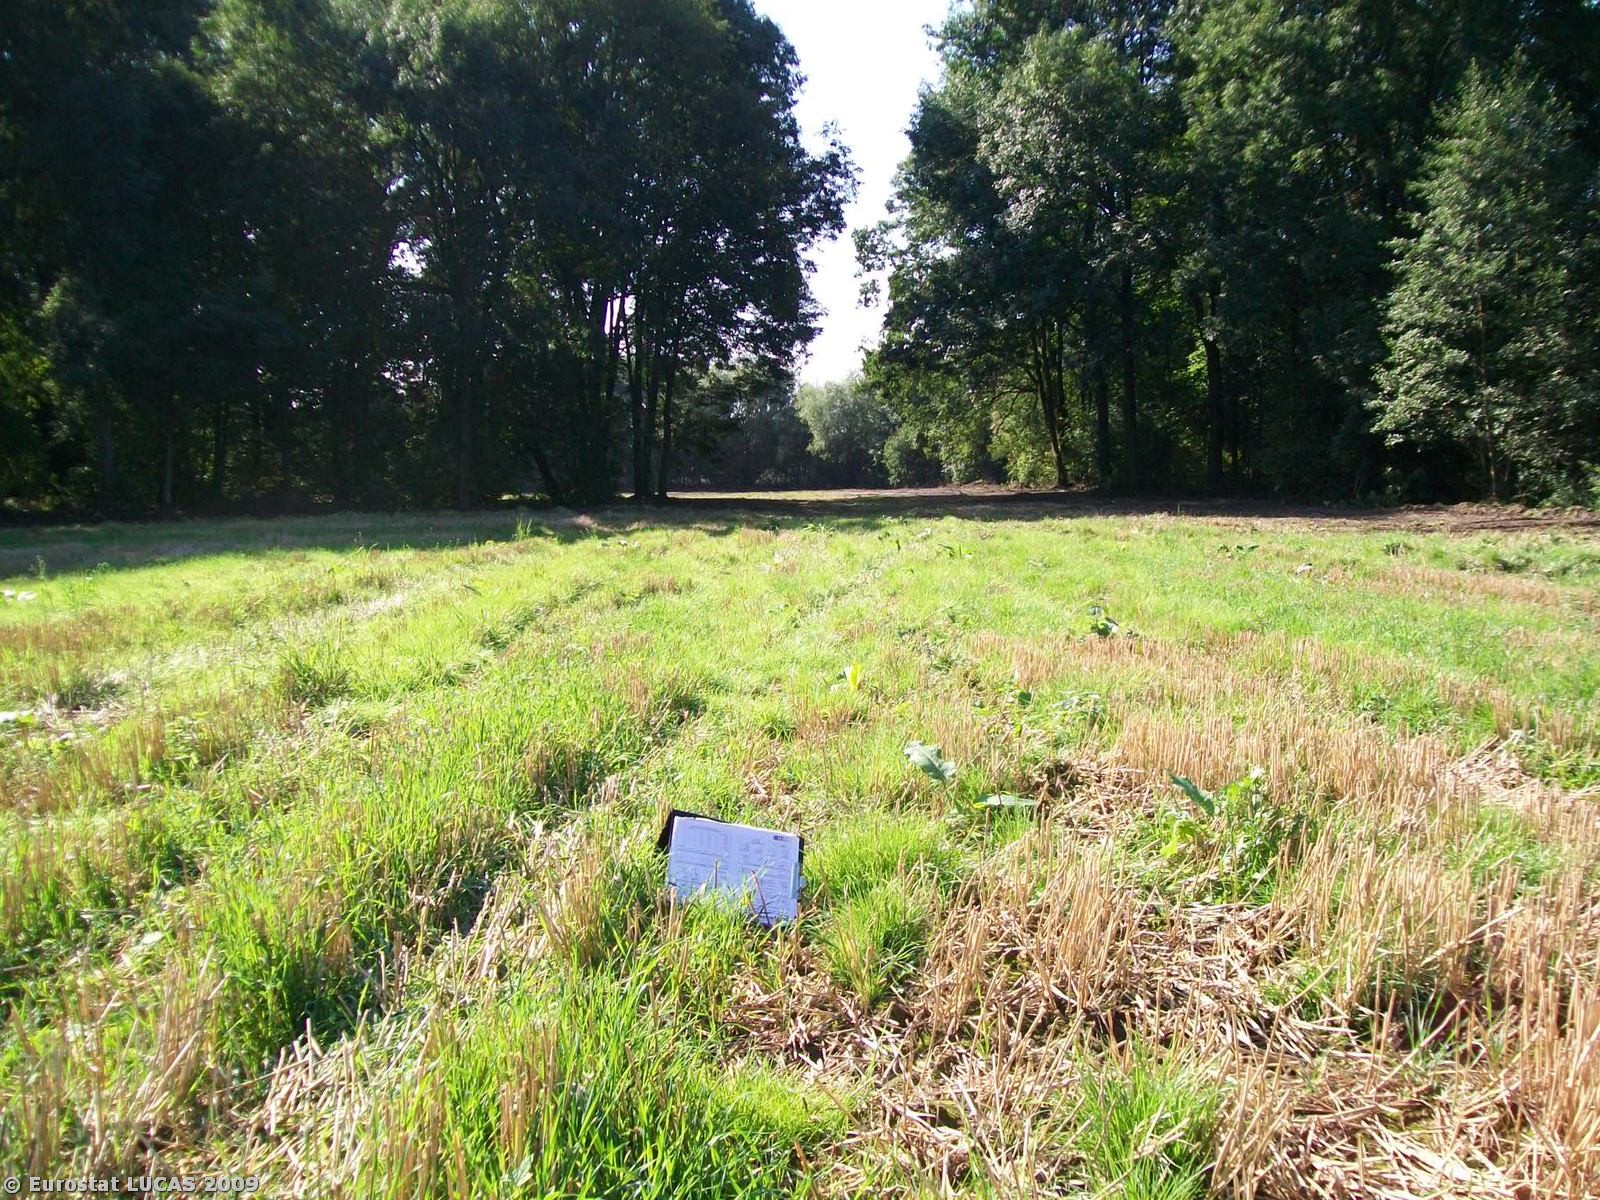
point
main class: Cropland
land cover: Common wheat
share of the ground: < 10 %
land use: Agriculture (excluding fallow land and kitchen gardens)
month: September
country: PL
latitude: 50.5151
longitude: 17.2176
